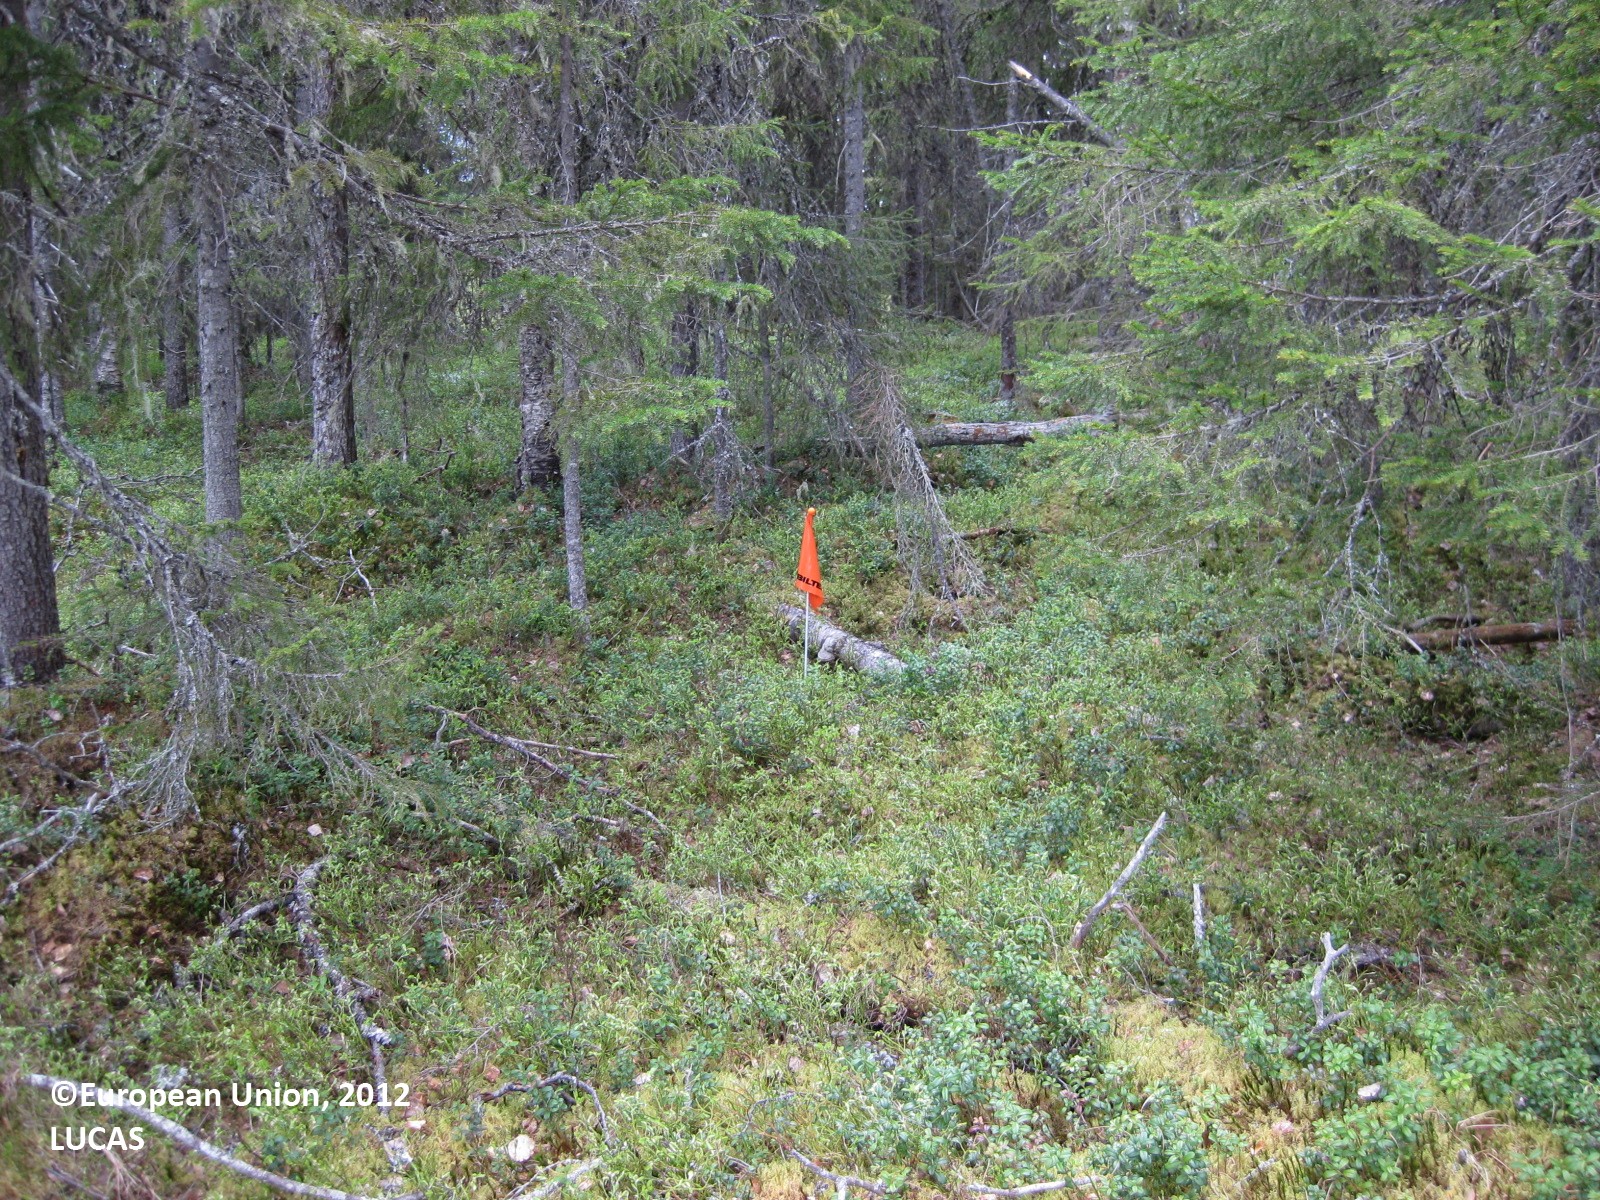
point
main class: Woodland
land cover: Spruce dominated coniferous woodland
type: boreal forest
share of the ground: > 75 %
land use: Forestry
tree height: > 5 m
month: June
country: FI
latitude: 65.3253
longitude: 29.1882
